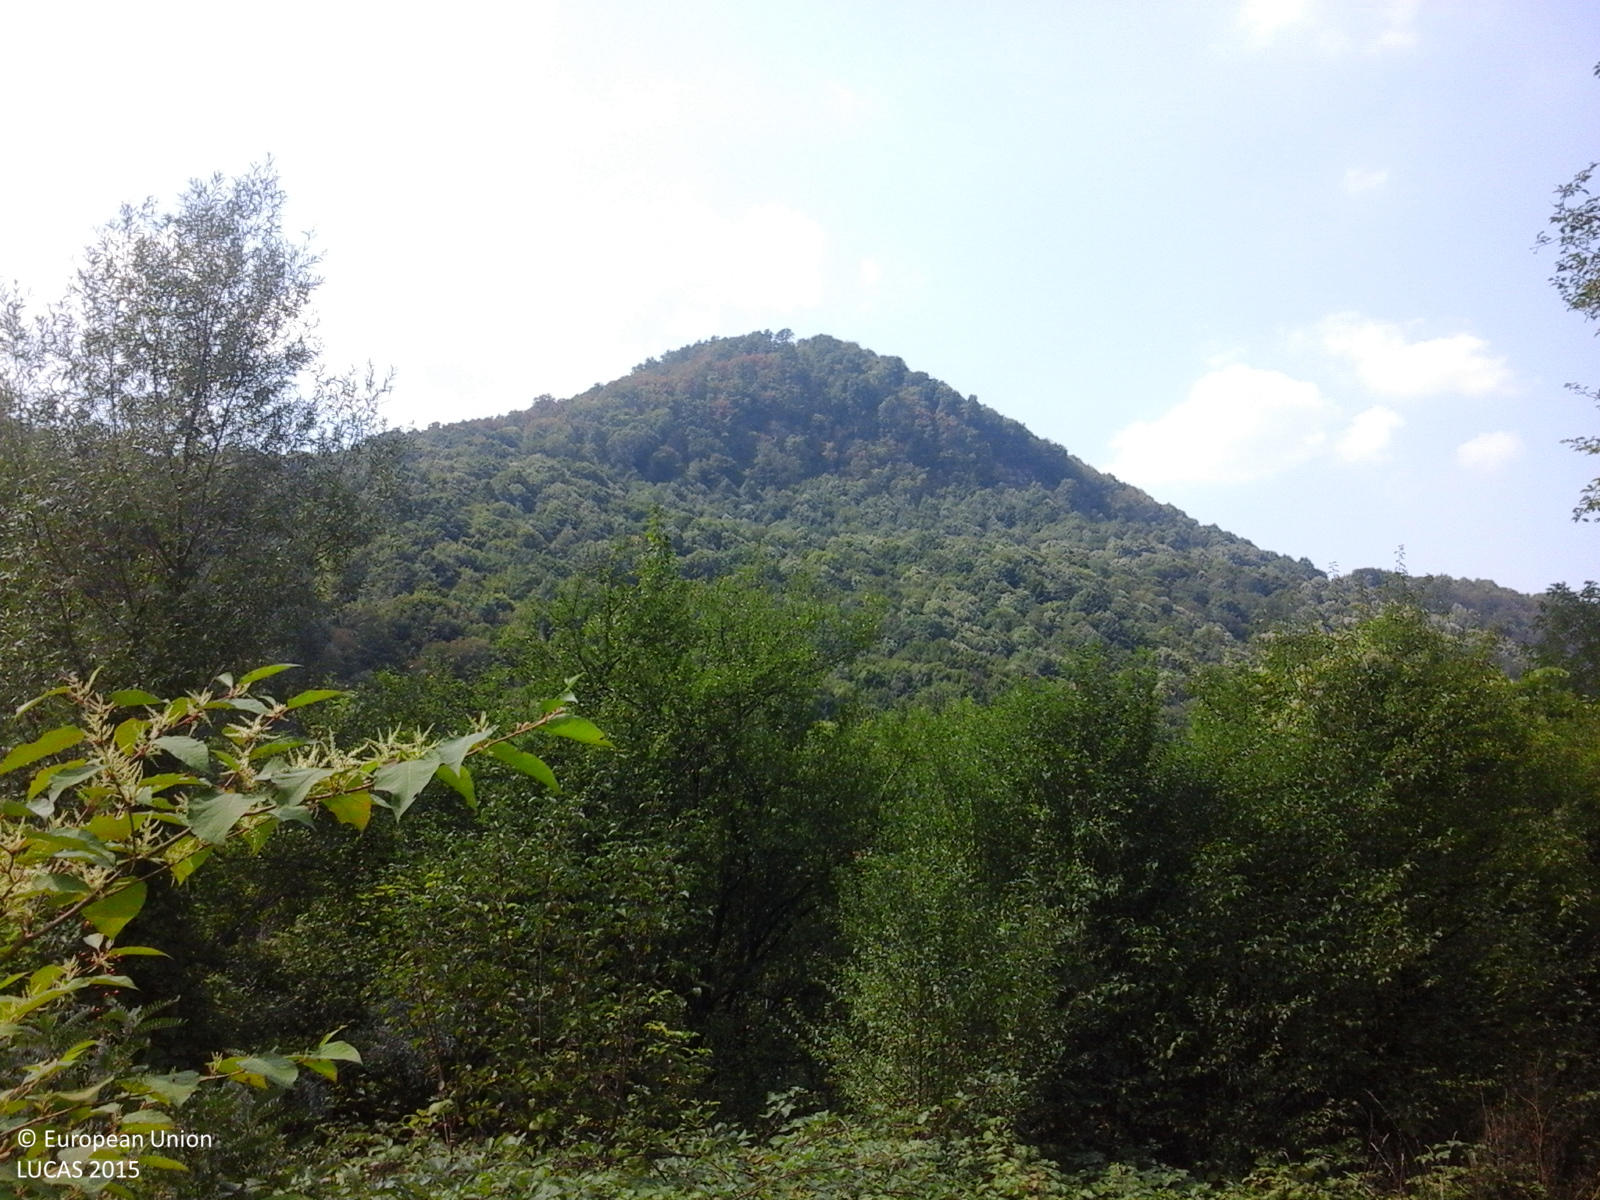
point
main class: Woodland
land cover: Broadleaved woodland
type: acidophilous oak and oak-birch forest
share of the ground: > 75 %
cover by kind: broadleaved forest trees 100 %
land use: Forestry
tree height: > 5 m
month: August
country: RO
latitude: 46.2772
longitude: 22.4427
